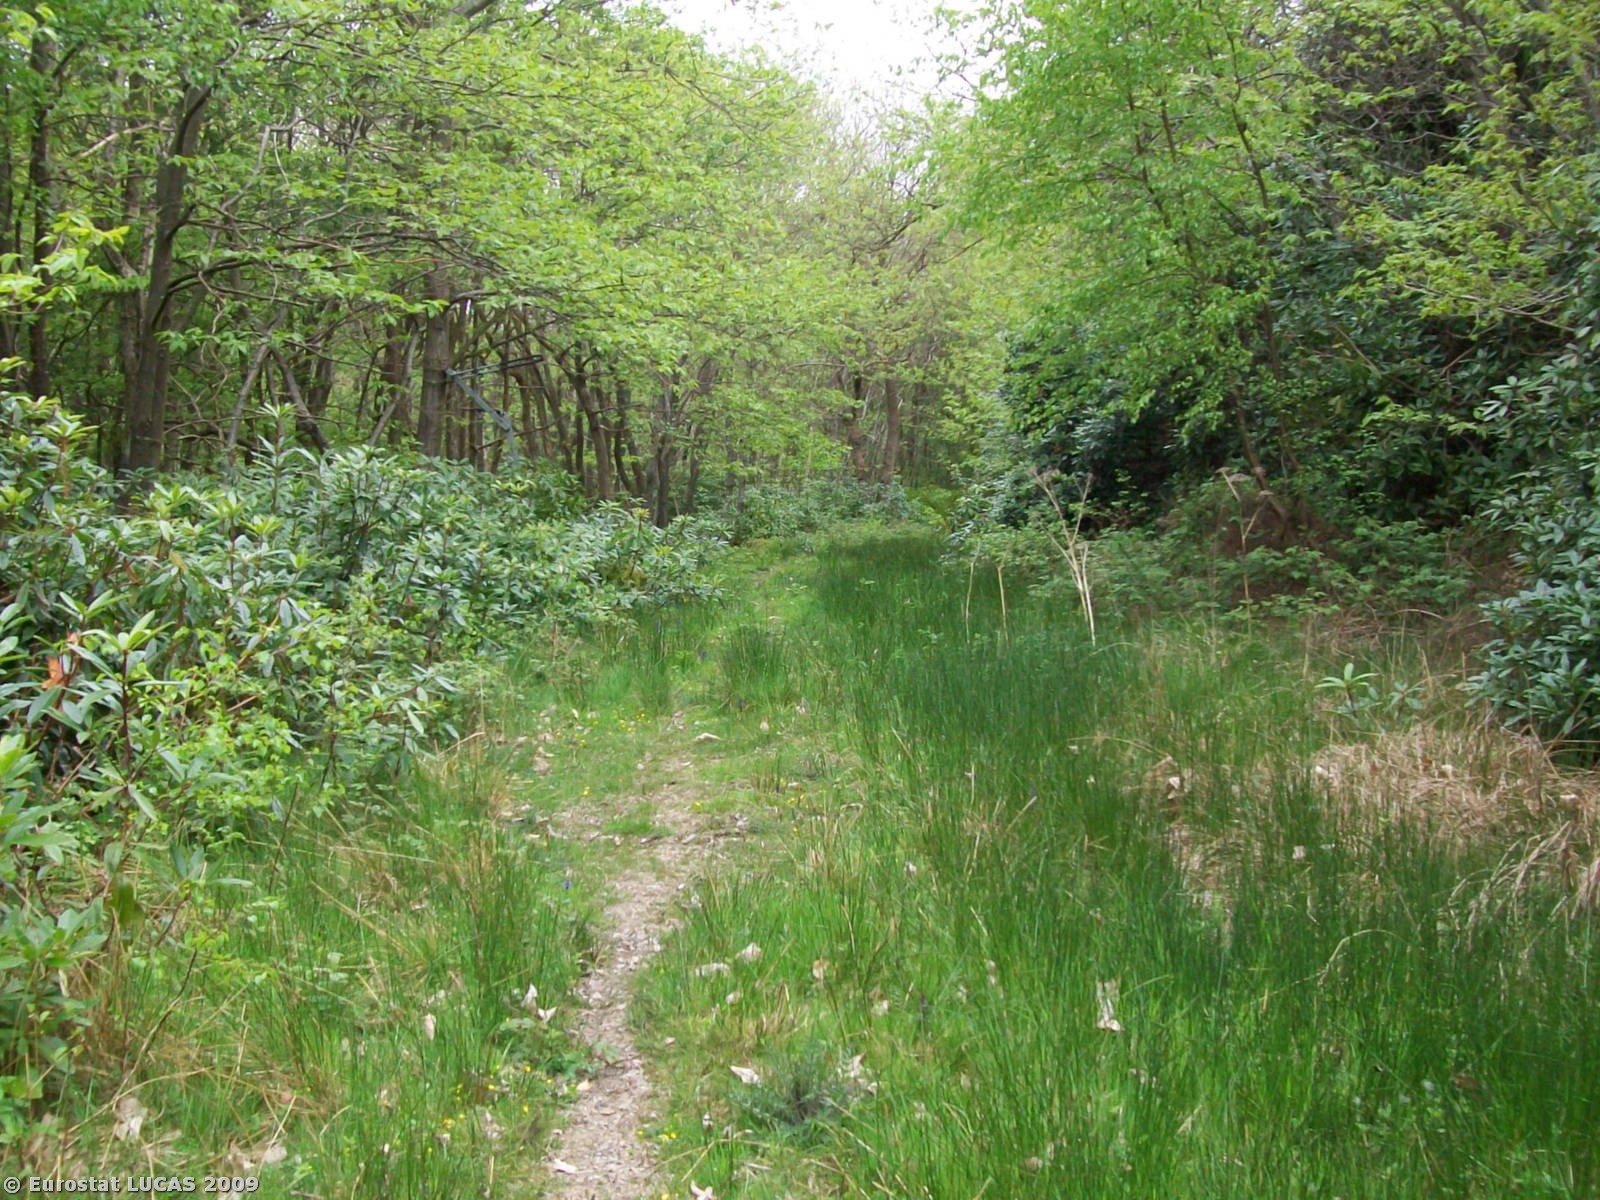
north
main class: Woodland
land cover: Mixed woodland
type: mesophytic deciduous forest
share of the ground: > 75 %
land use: Forestry
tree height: > 5 m
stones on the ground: < 10 %
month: May
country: GB
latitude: 51.1125
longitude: 0.3286
